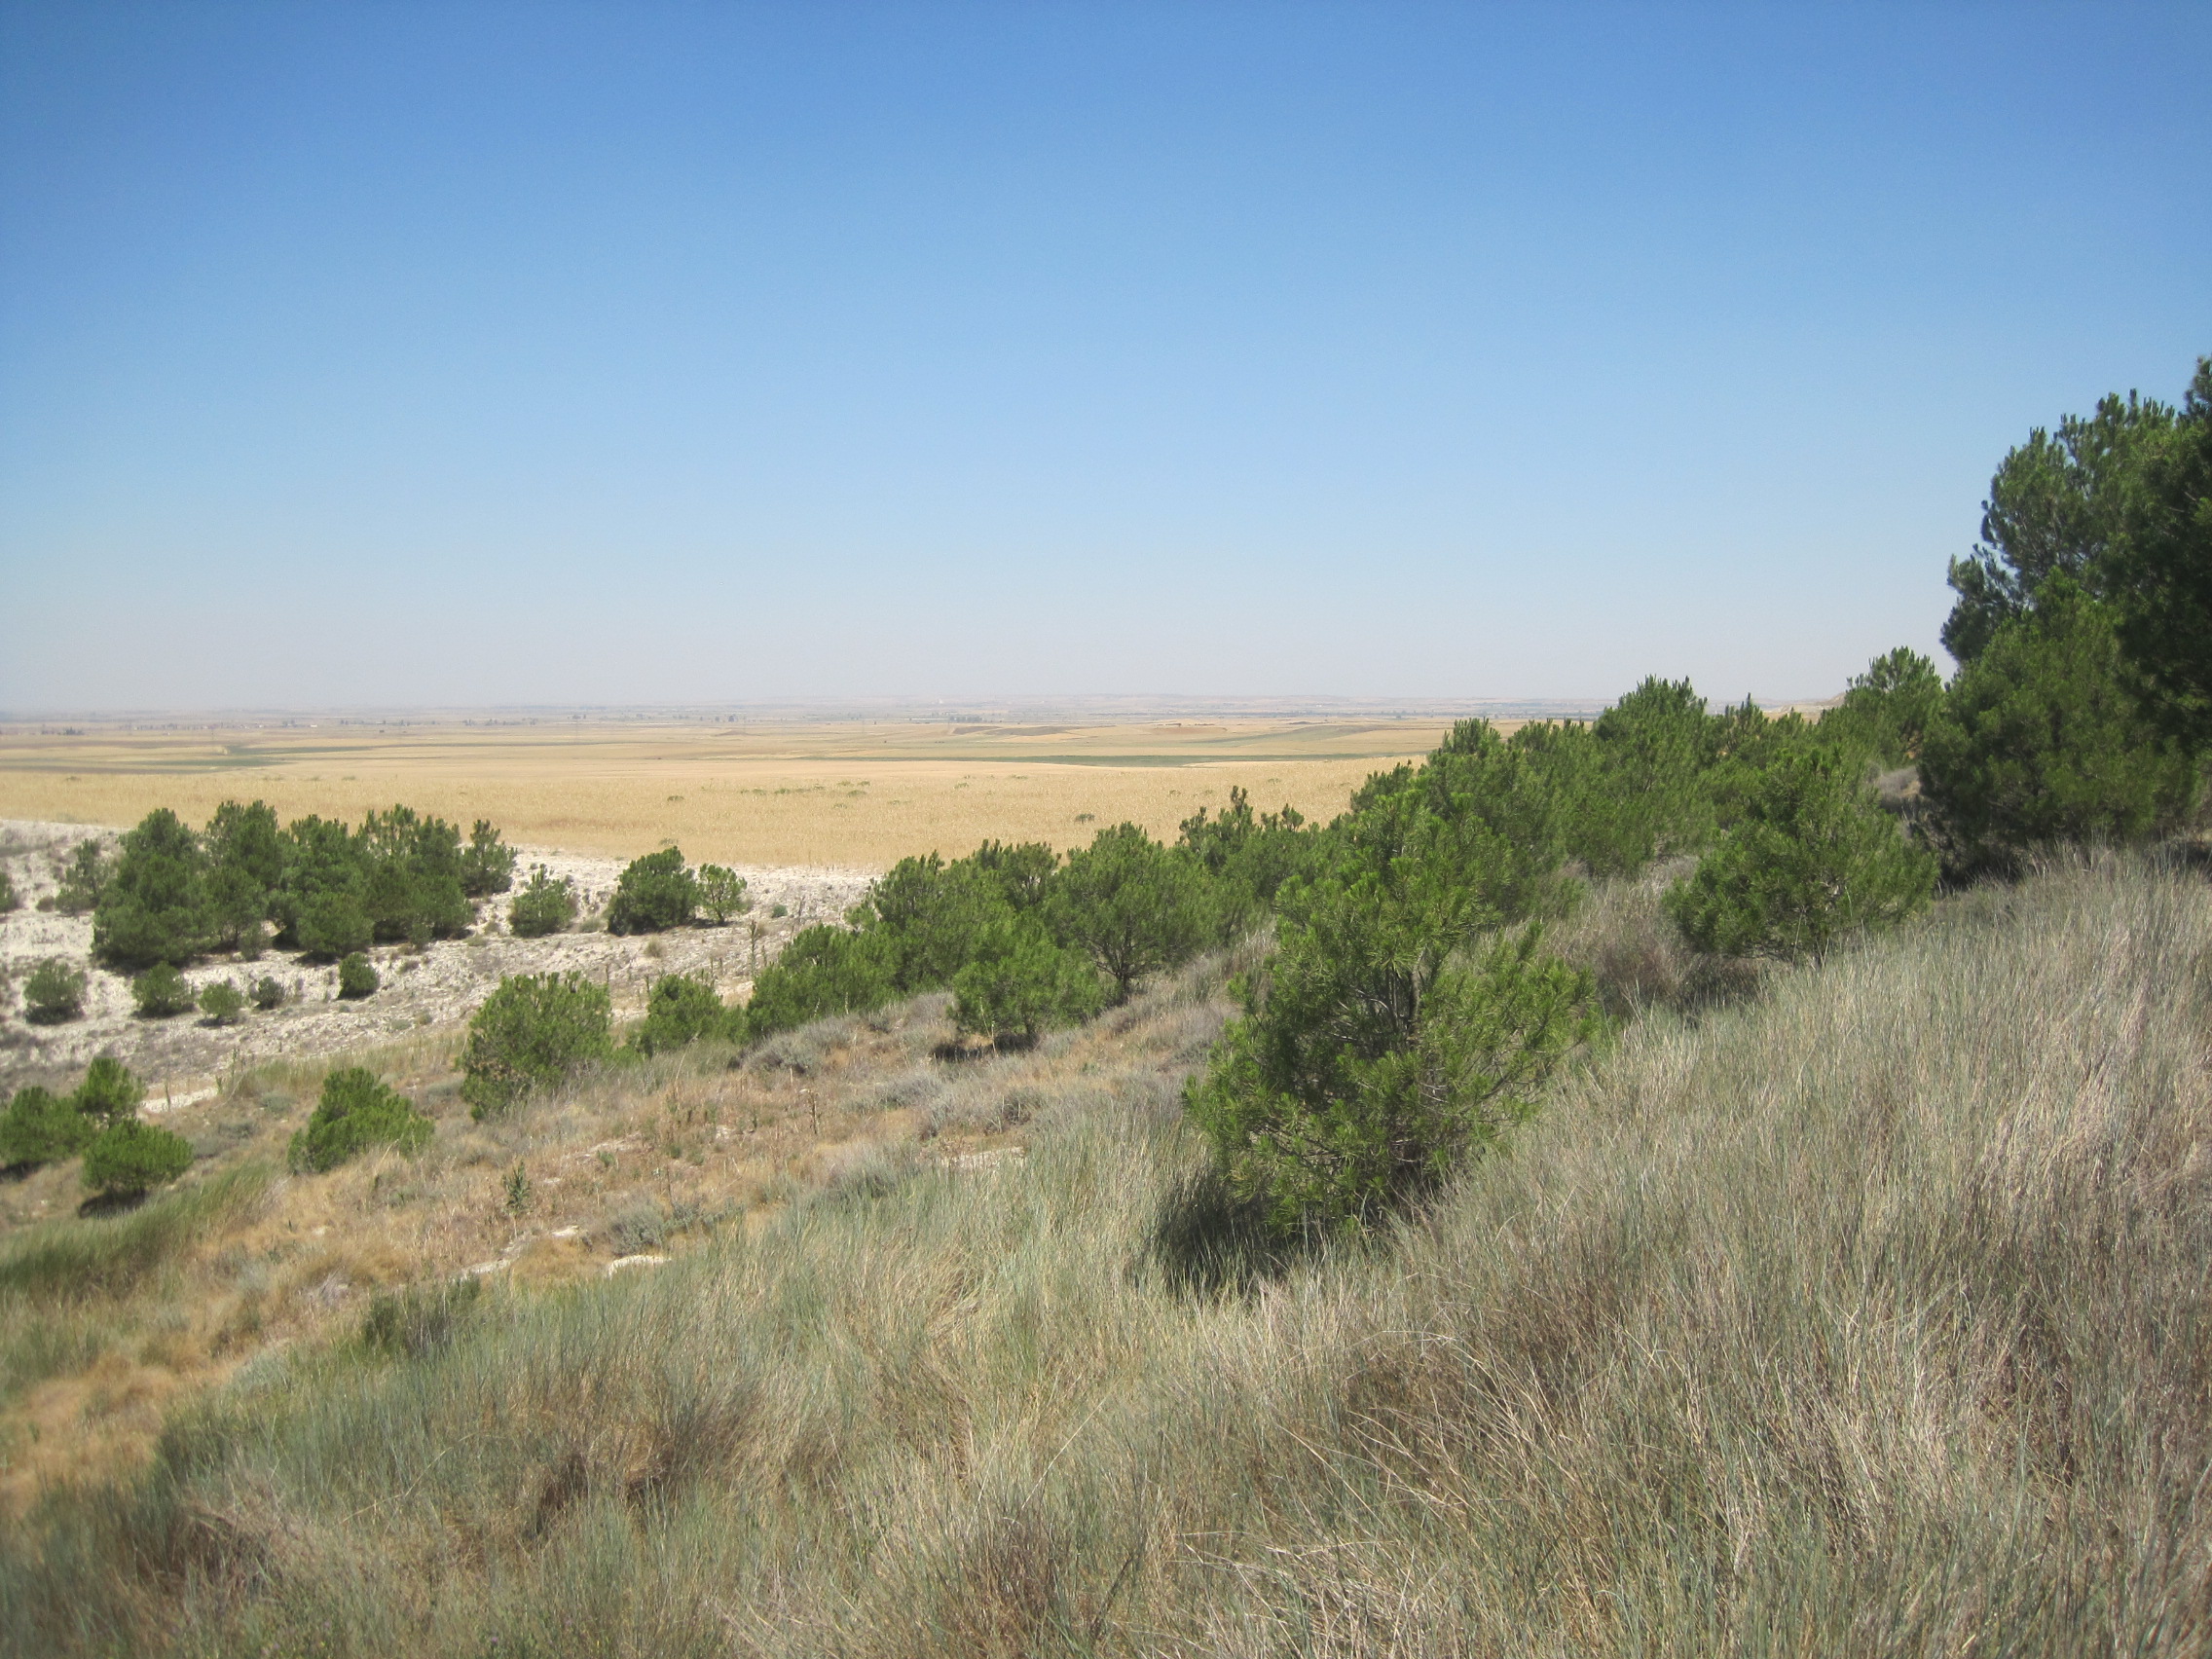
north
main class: Woodland
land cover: Pine dominated coniferous woodland
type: coniferous forest of the mediterranean region
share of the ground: 25 - 50 %
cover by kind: herbaceous plants 60 %, coniferous forest trees 40 %
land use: Semi-natural and natural areas not in use
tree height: > 5 m
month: July
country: ES
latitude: 41.9621
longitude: -4.6837
